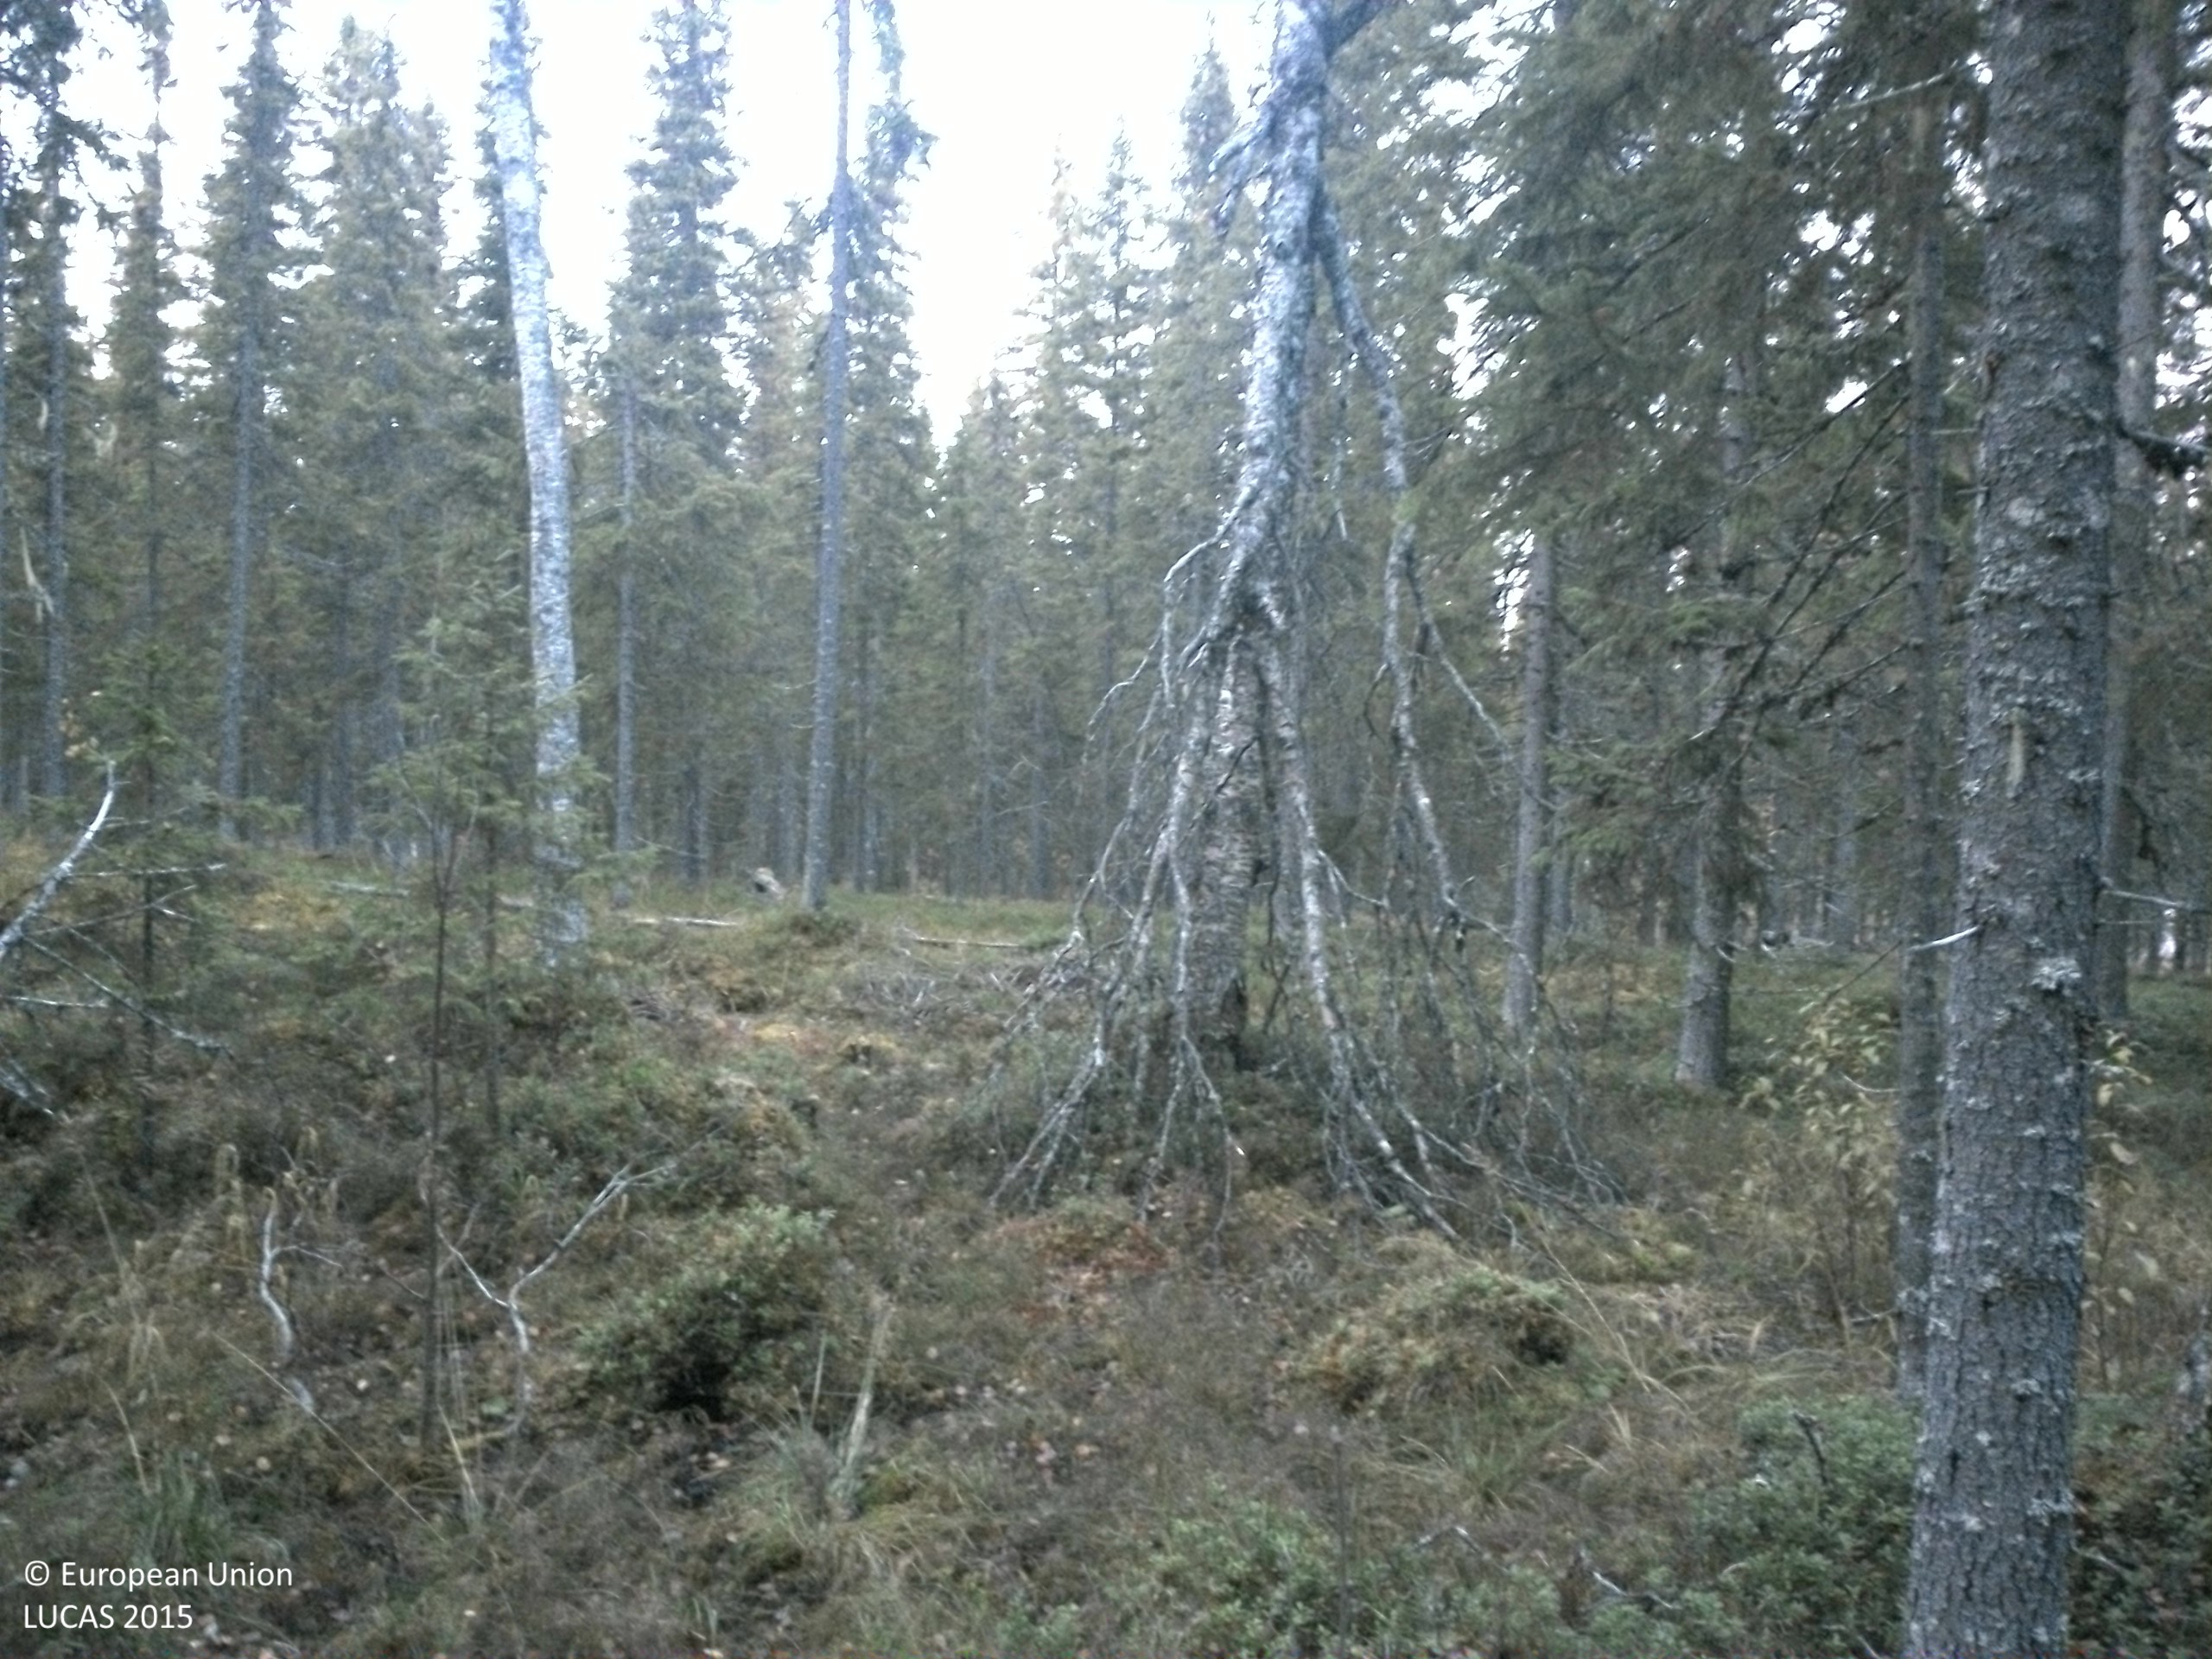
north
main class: Woodland
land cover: Spruce dominated coniferous woodland
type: boreal forest
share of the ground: 25 - 50 %
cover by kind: coniferous forest trees 40 %, shrubs 40 %, lichens and mosses 20 %
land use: Forestry
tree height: > 5 m
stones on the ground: < 10 %
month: October
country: SE
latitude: 64.2181
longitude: 15.8436
